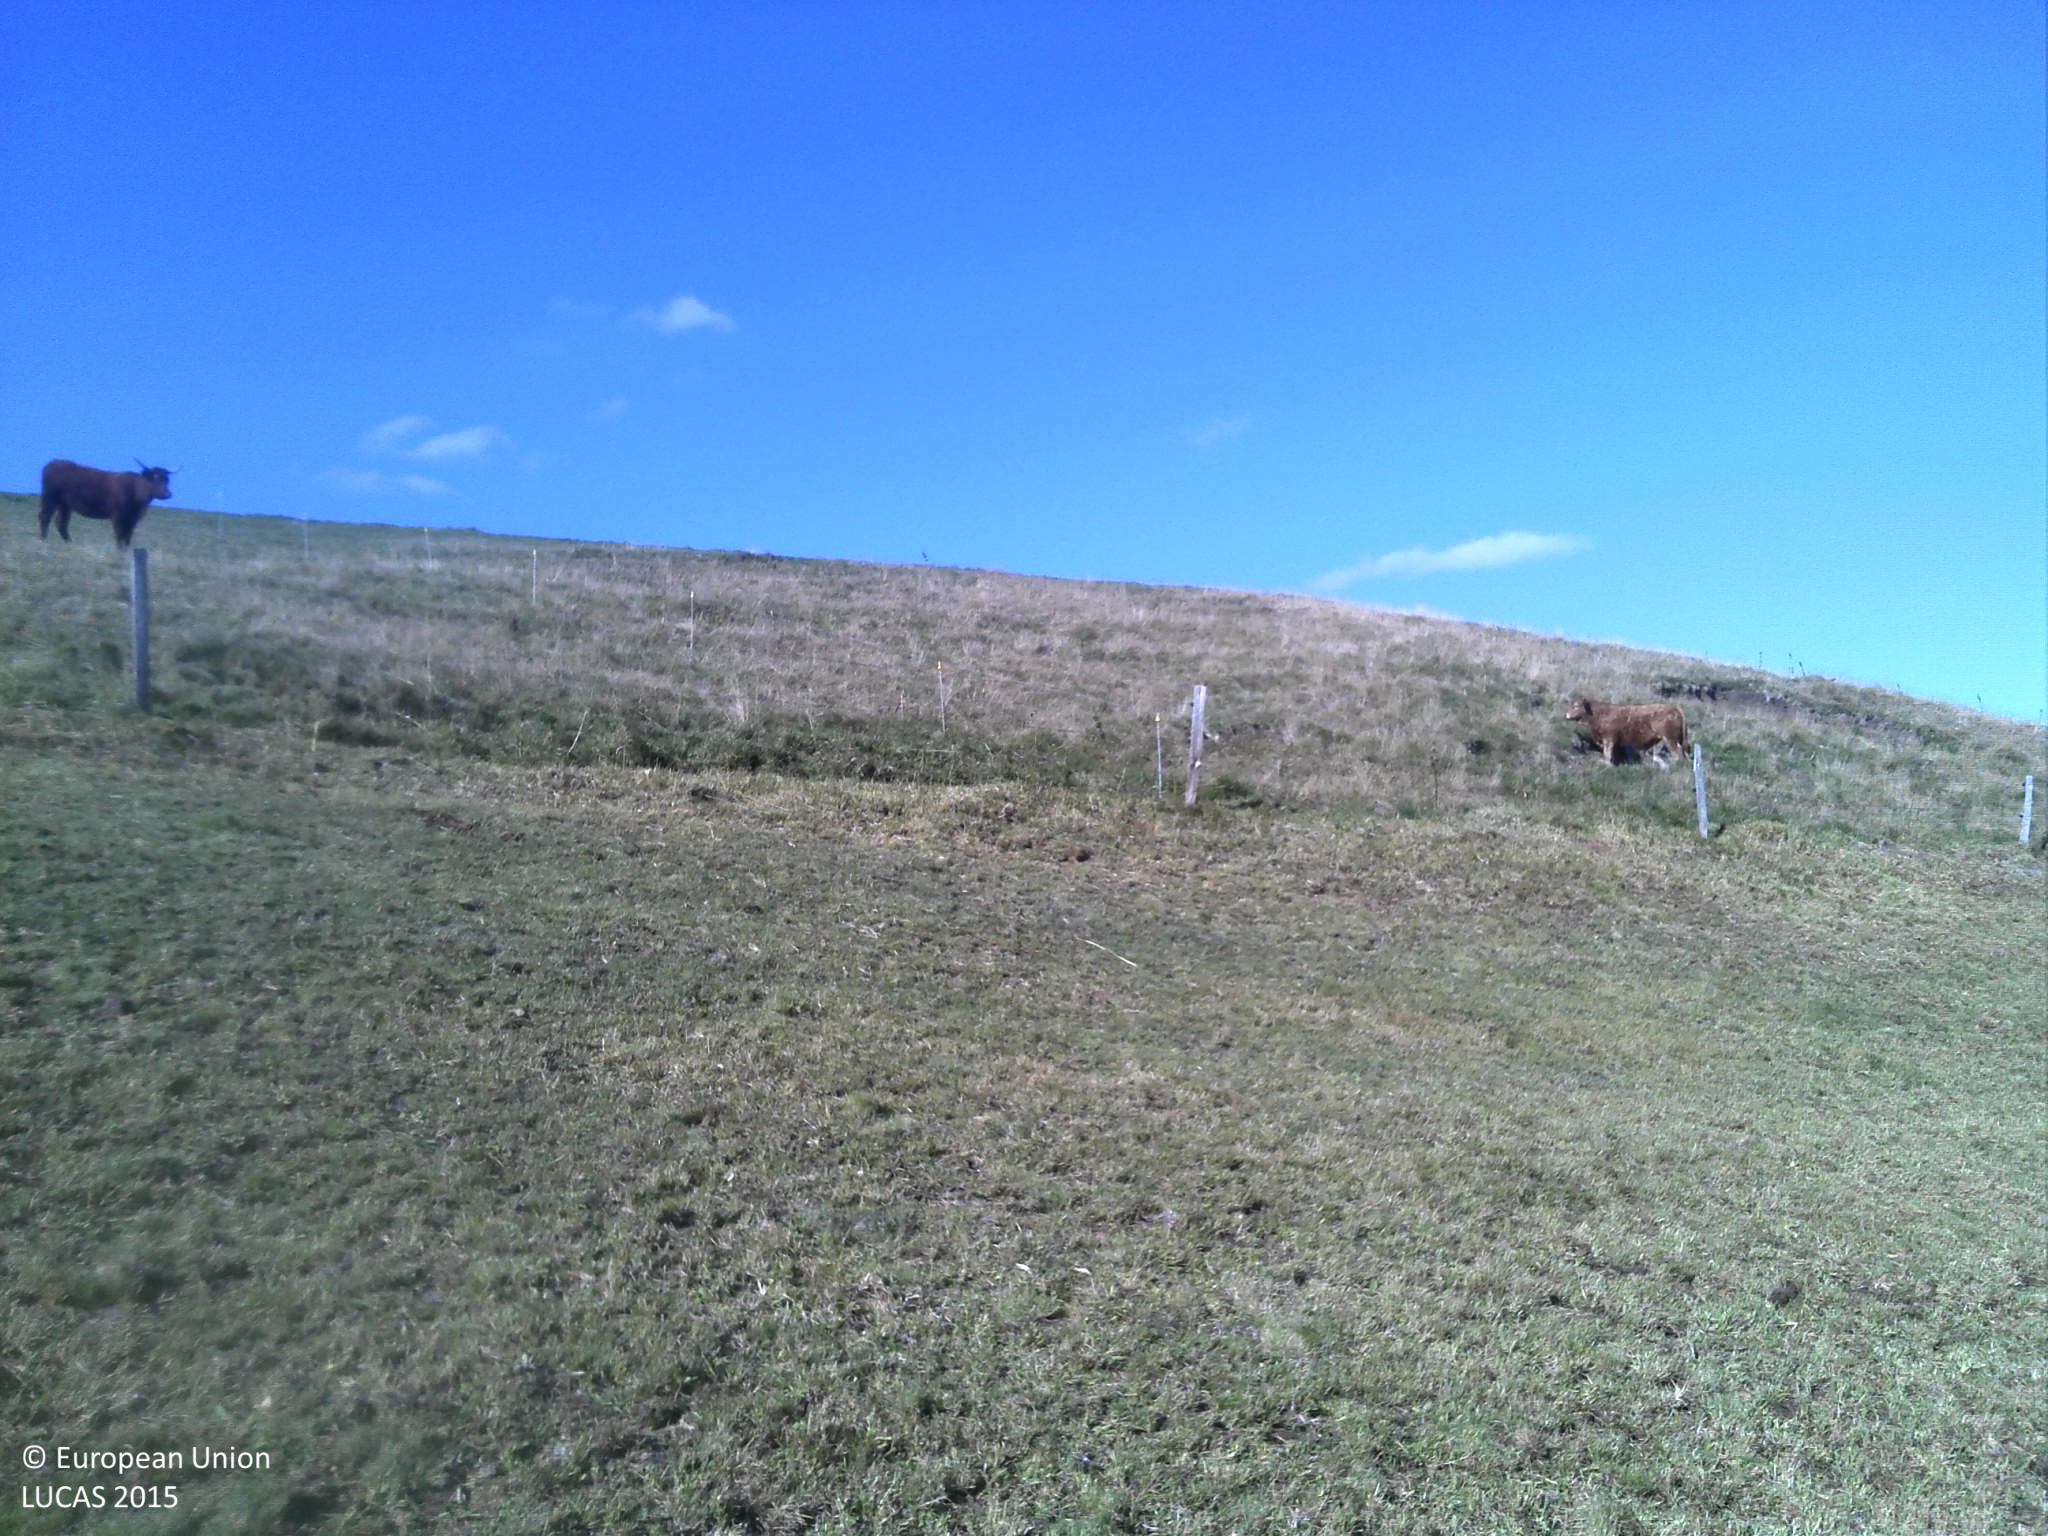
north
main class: Grassland
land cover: Grassland without tree/shrub cover
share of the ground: > 75 %
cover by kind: herbaceous plants 100 %
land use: Agriculture (excluding fallow land and kitchen gardens)
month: September
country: FR
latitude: 45.4788
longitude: 2.8487
